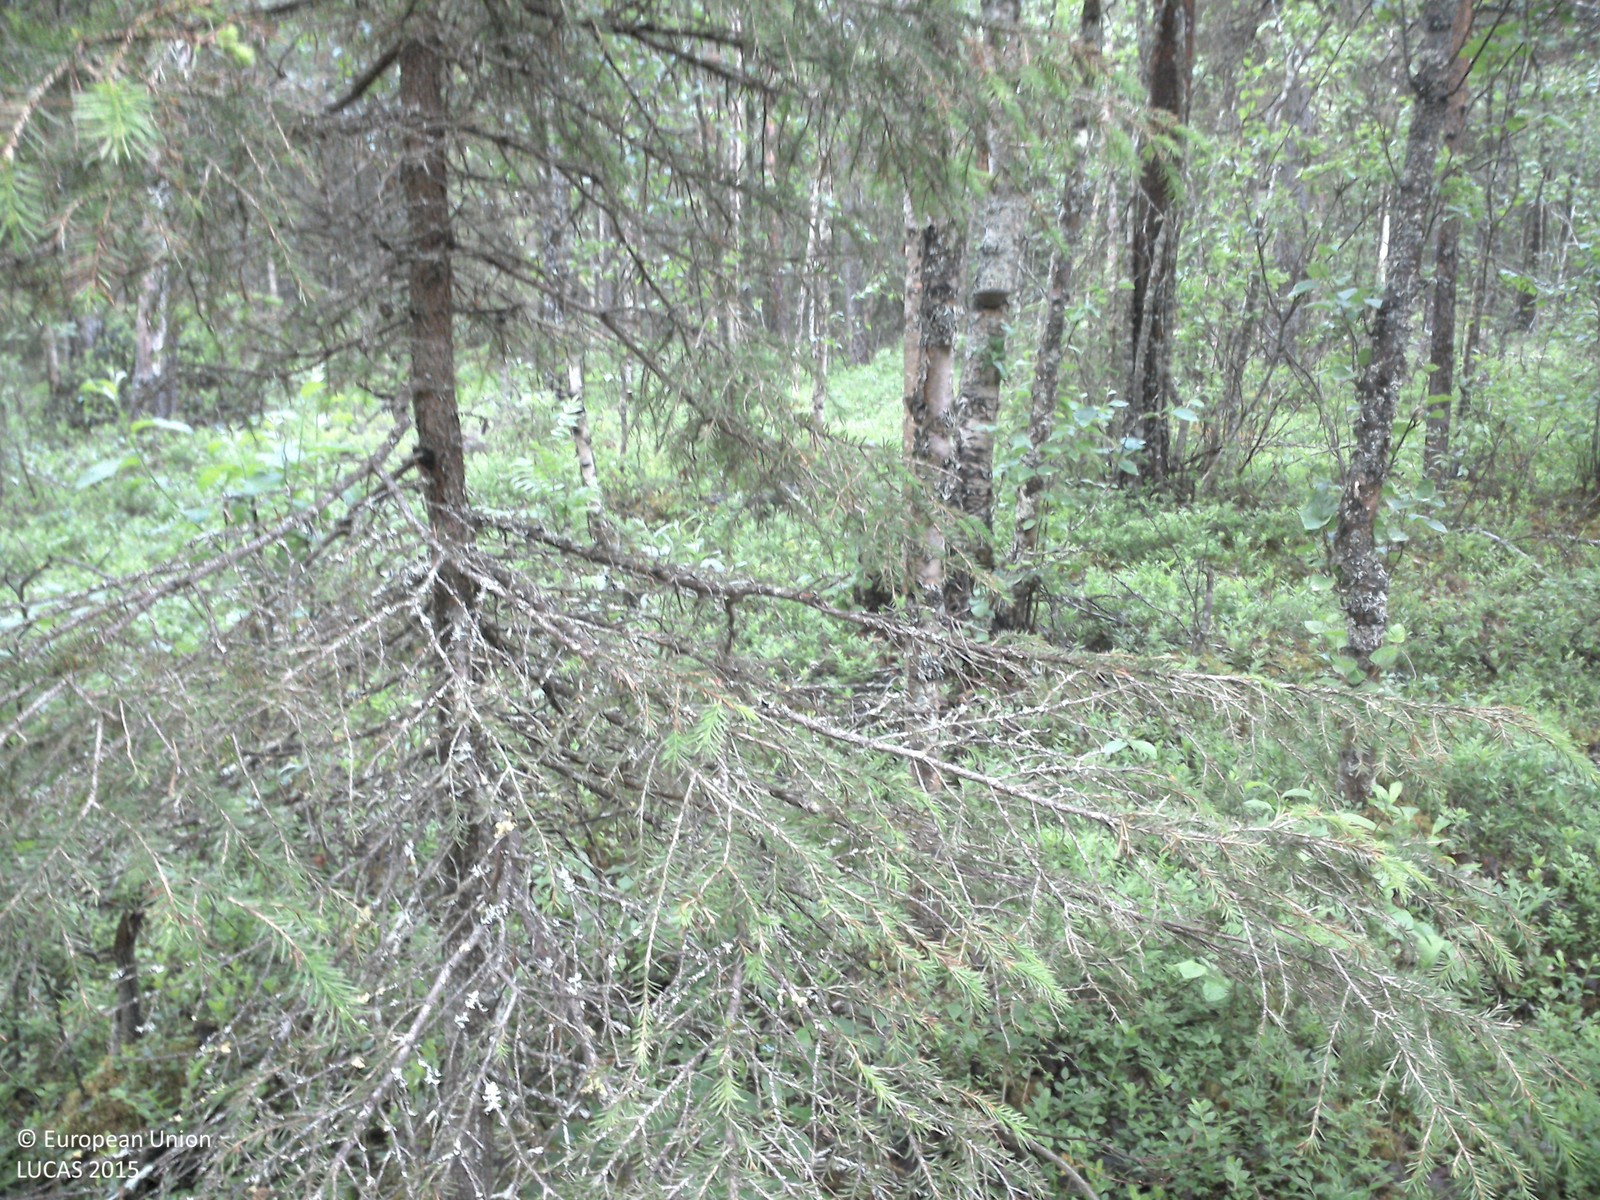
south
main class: Woodland
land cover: Pine dominated mixed woodland
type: boreal forest
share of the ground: 25 - 50 %
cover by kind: shrubs 65 %, coniferous forest trees 20 %, broadleaved forest trees 15 %
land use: Forestry
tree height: > 5 m
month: July
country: SE
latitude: 66.9578
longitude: 23.8335
